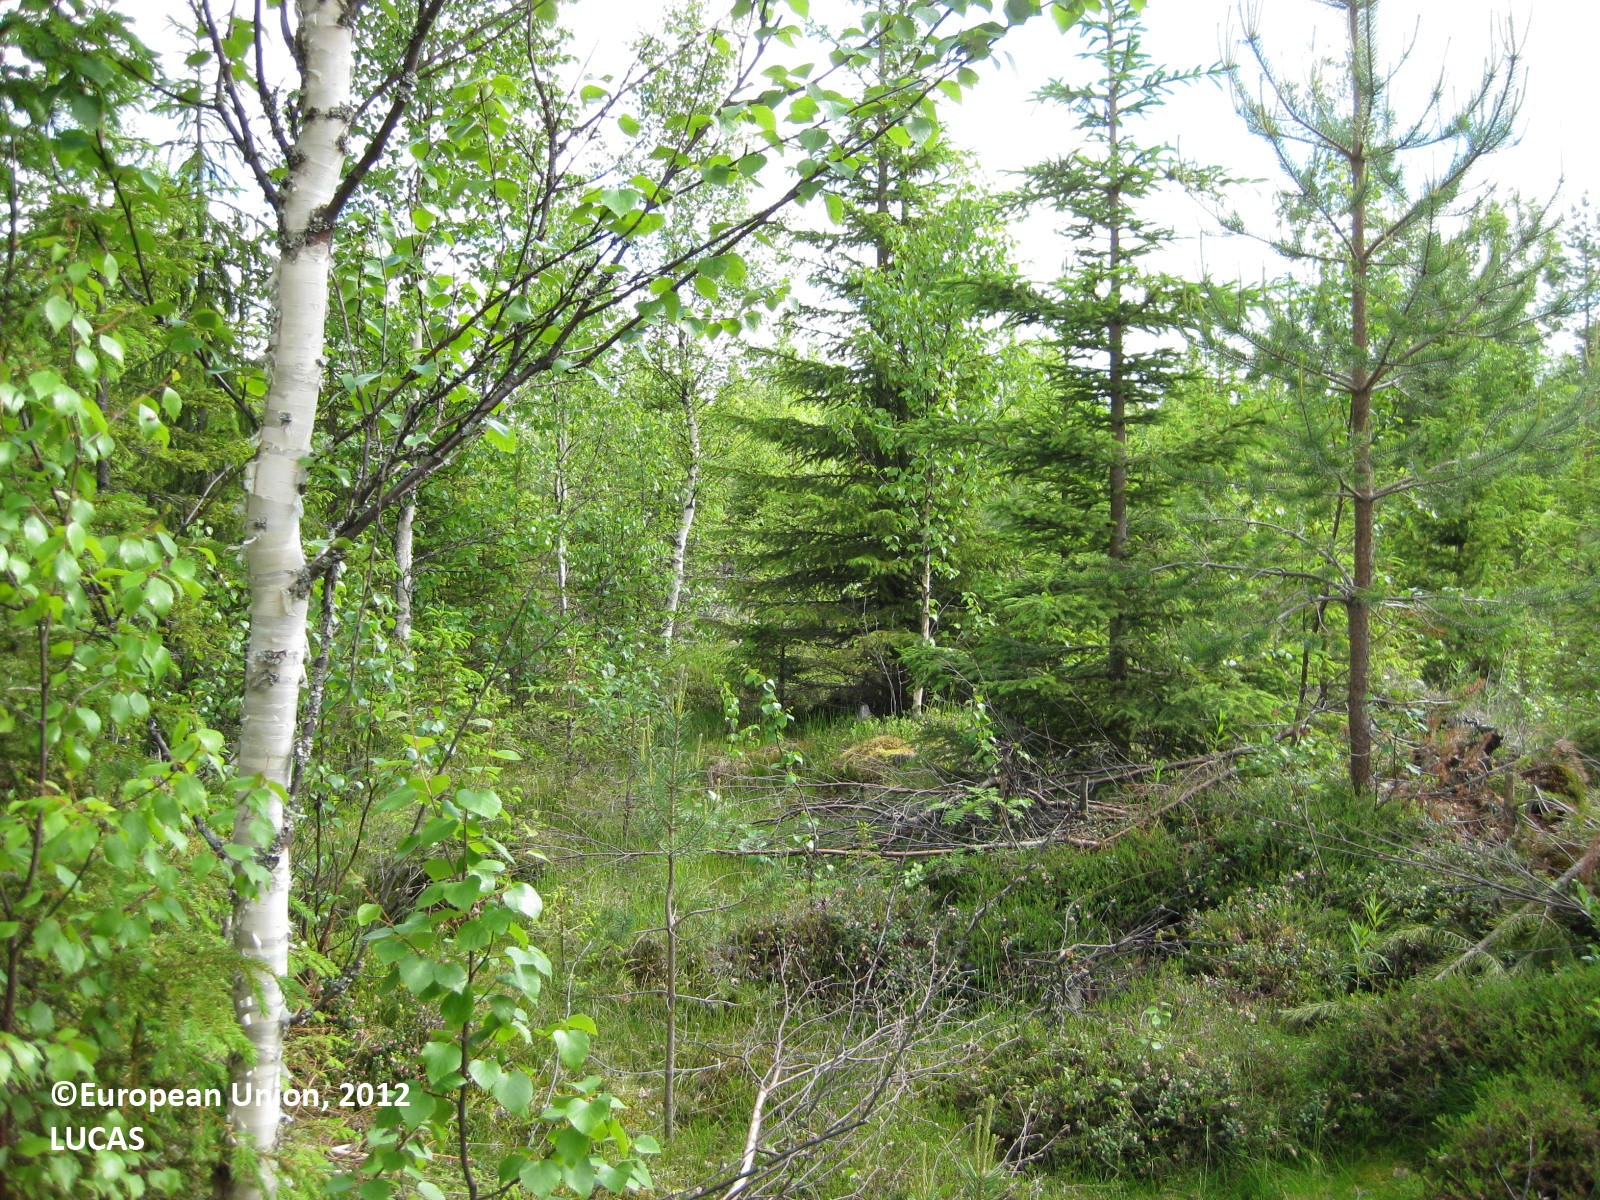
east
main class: Woodland
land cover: Spruce dominated mixed woodland
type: boreal forest
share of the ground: 50 - 75 %
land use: Forestry
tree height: > 5 m
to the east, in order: Spruce dominated mixed woodland; Ditches and canals; Spruce dominated mixed woodland; Ditches and canals; Spruce dominated mixed woodland; Ditches and canals; Spruce dominated mixed woodland; Ditches and canals; Spruce dominated mixed woodland; Ditches and canals; Spruce dominated mixed woodland; Ditches and canals; Spruce dominated mixed woodland; Ditches and canals; Spruce dominated mixed woodland; Broadleaved woodland; Spruce dominated mixed woodland; Ditches and canals; Spruce dominated mixed woodland
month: June
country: FI
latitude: 65.3523
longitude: 28.3165
